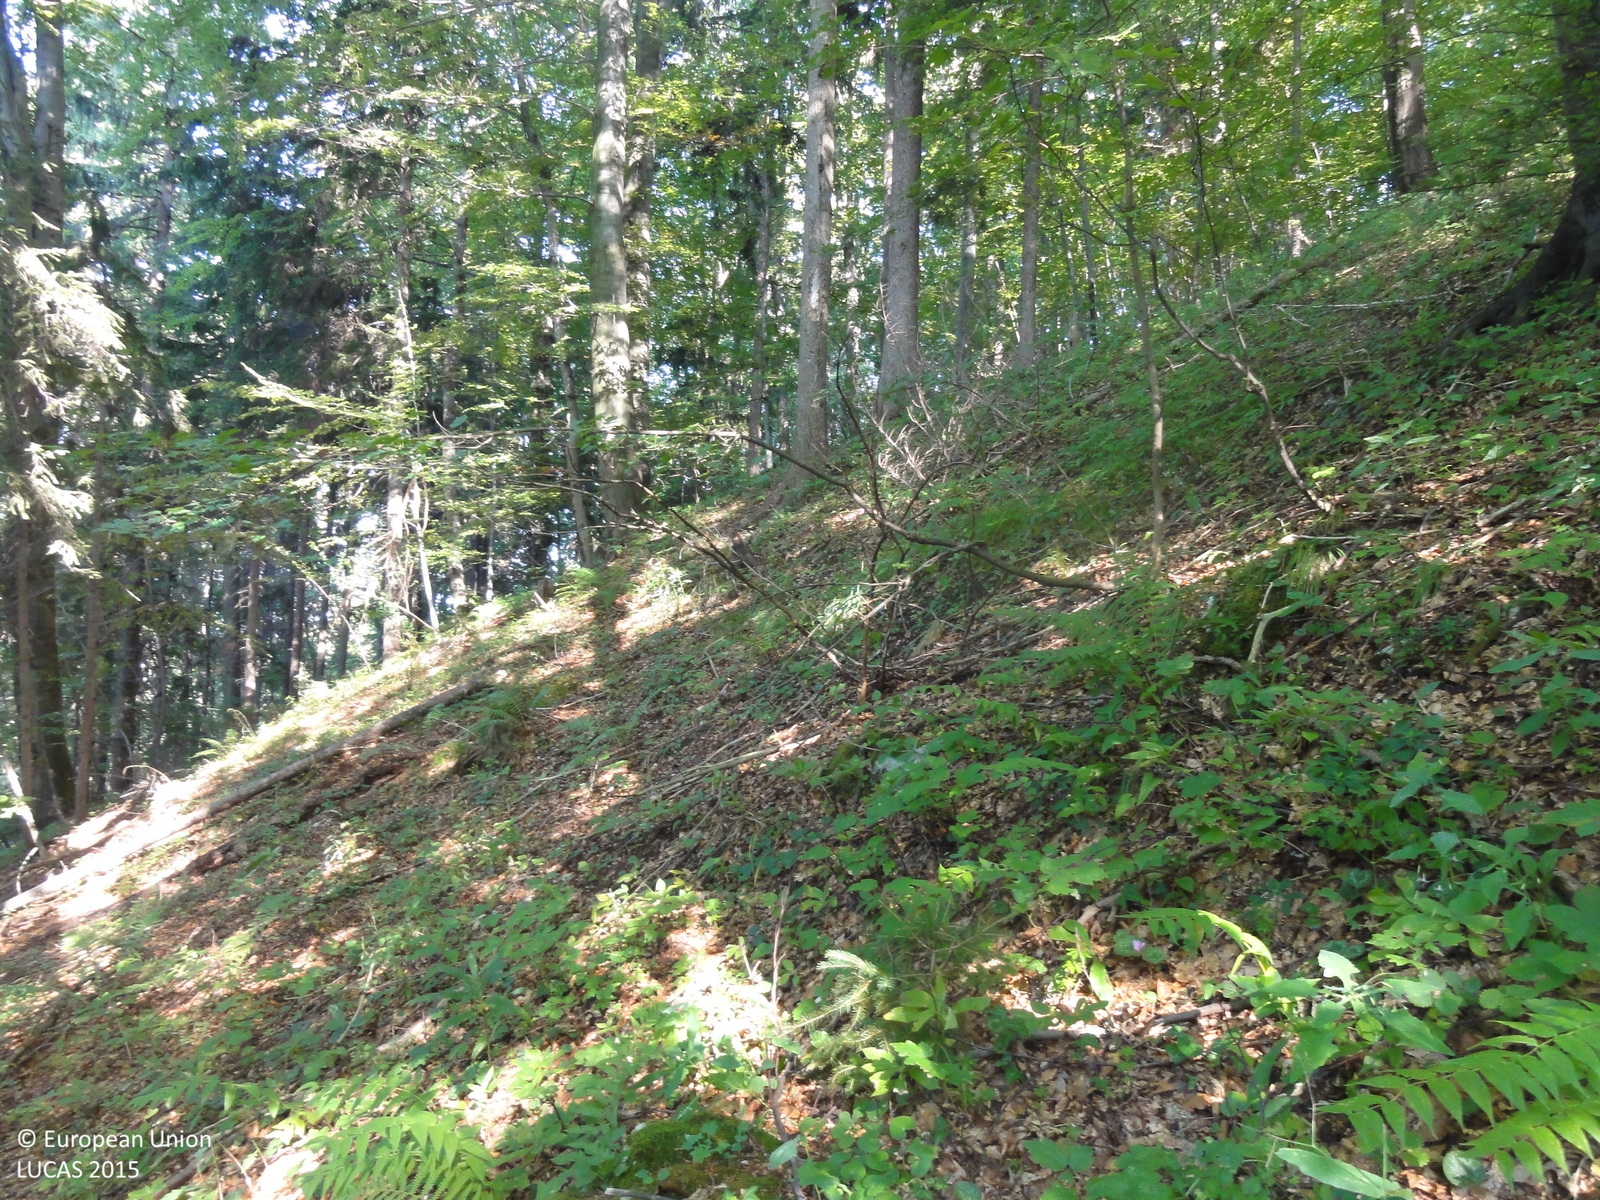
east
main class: Woodland
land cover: Broadleaved woodland
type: beech forest
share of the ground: > 75 %
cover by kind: broadleaved forest trees 90 %, coniferous forest trees 10 %
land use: Forestry
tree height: > 5 m
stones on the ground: 10 - 25 %
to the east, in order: Broadleaved woodland; Spruce dominated mixed woodland; Tracks; Broadleaved woodland; Spruce dominated mixed woodland
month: August
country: SI
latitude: 46.1041
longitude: 15.0813
